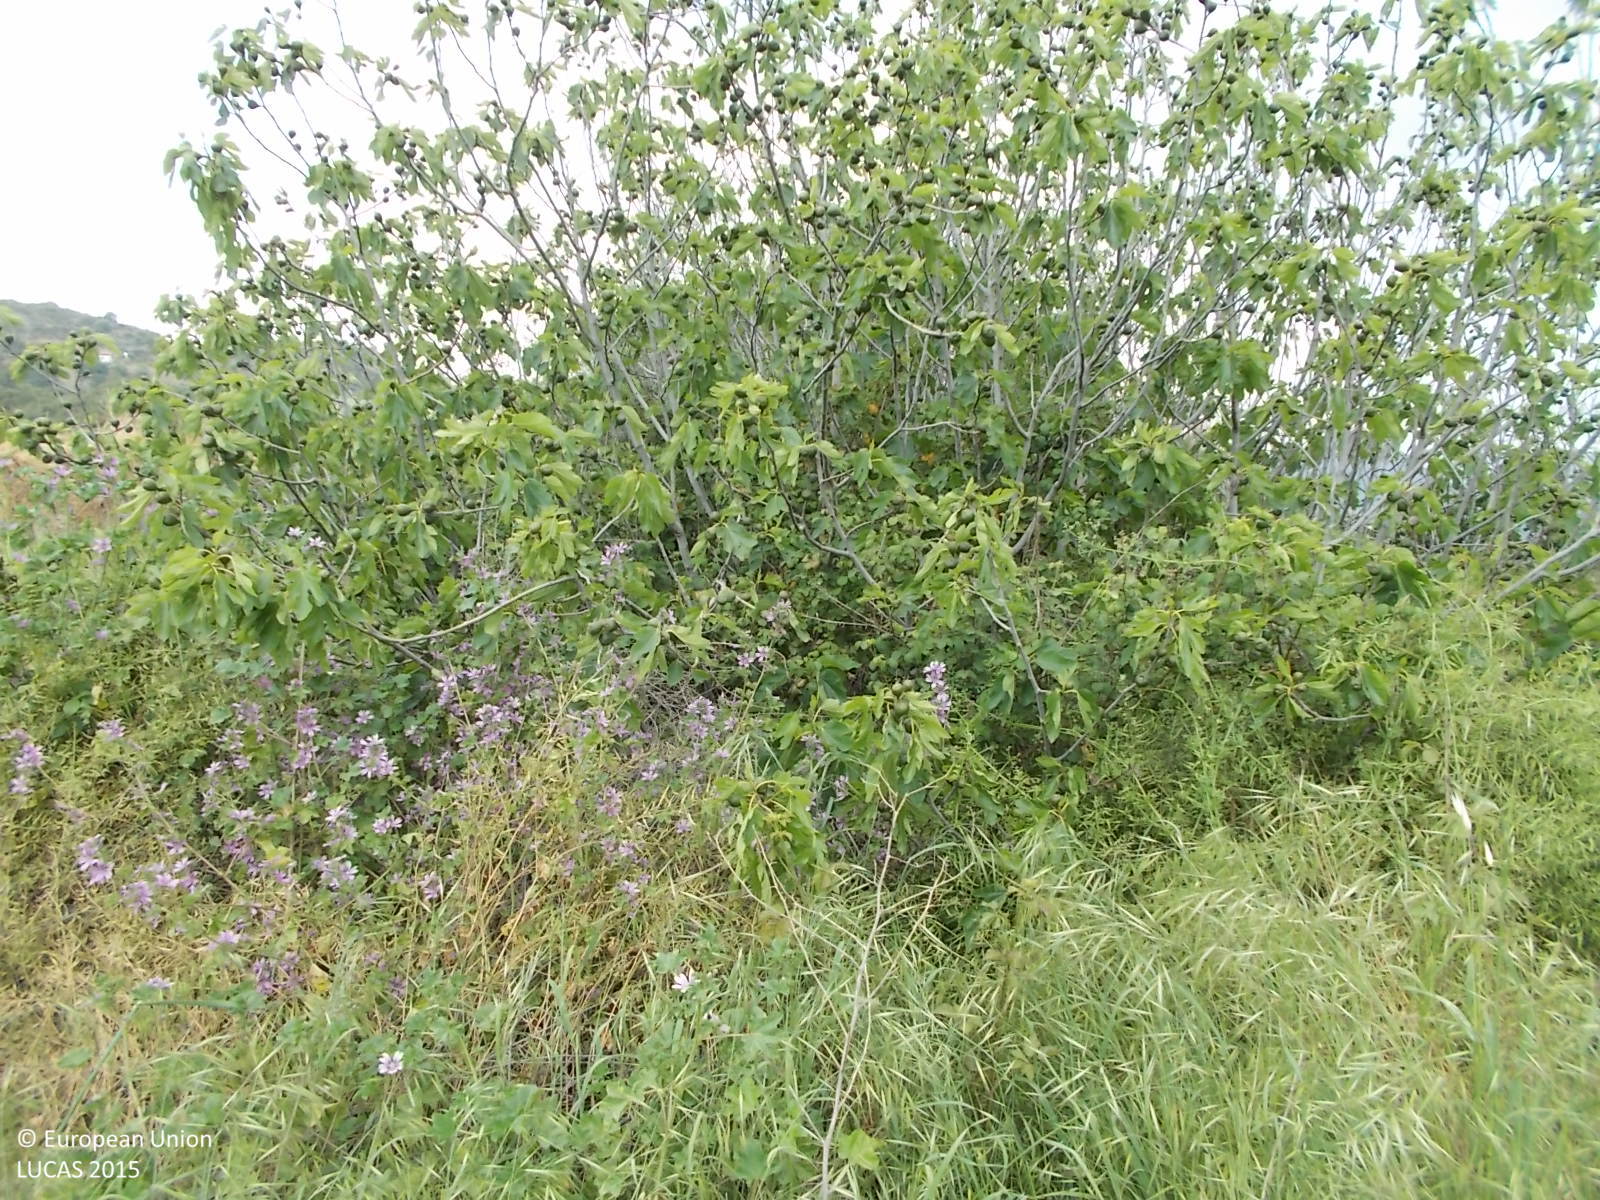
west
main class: Grassland
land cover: Spontaneously vegetated surfaces
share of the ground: > 75 %
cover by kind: herbaceous plants 100 %
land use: Fallow land
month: April
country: CY
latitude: 34.8140
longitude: 33.1414
